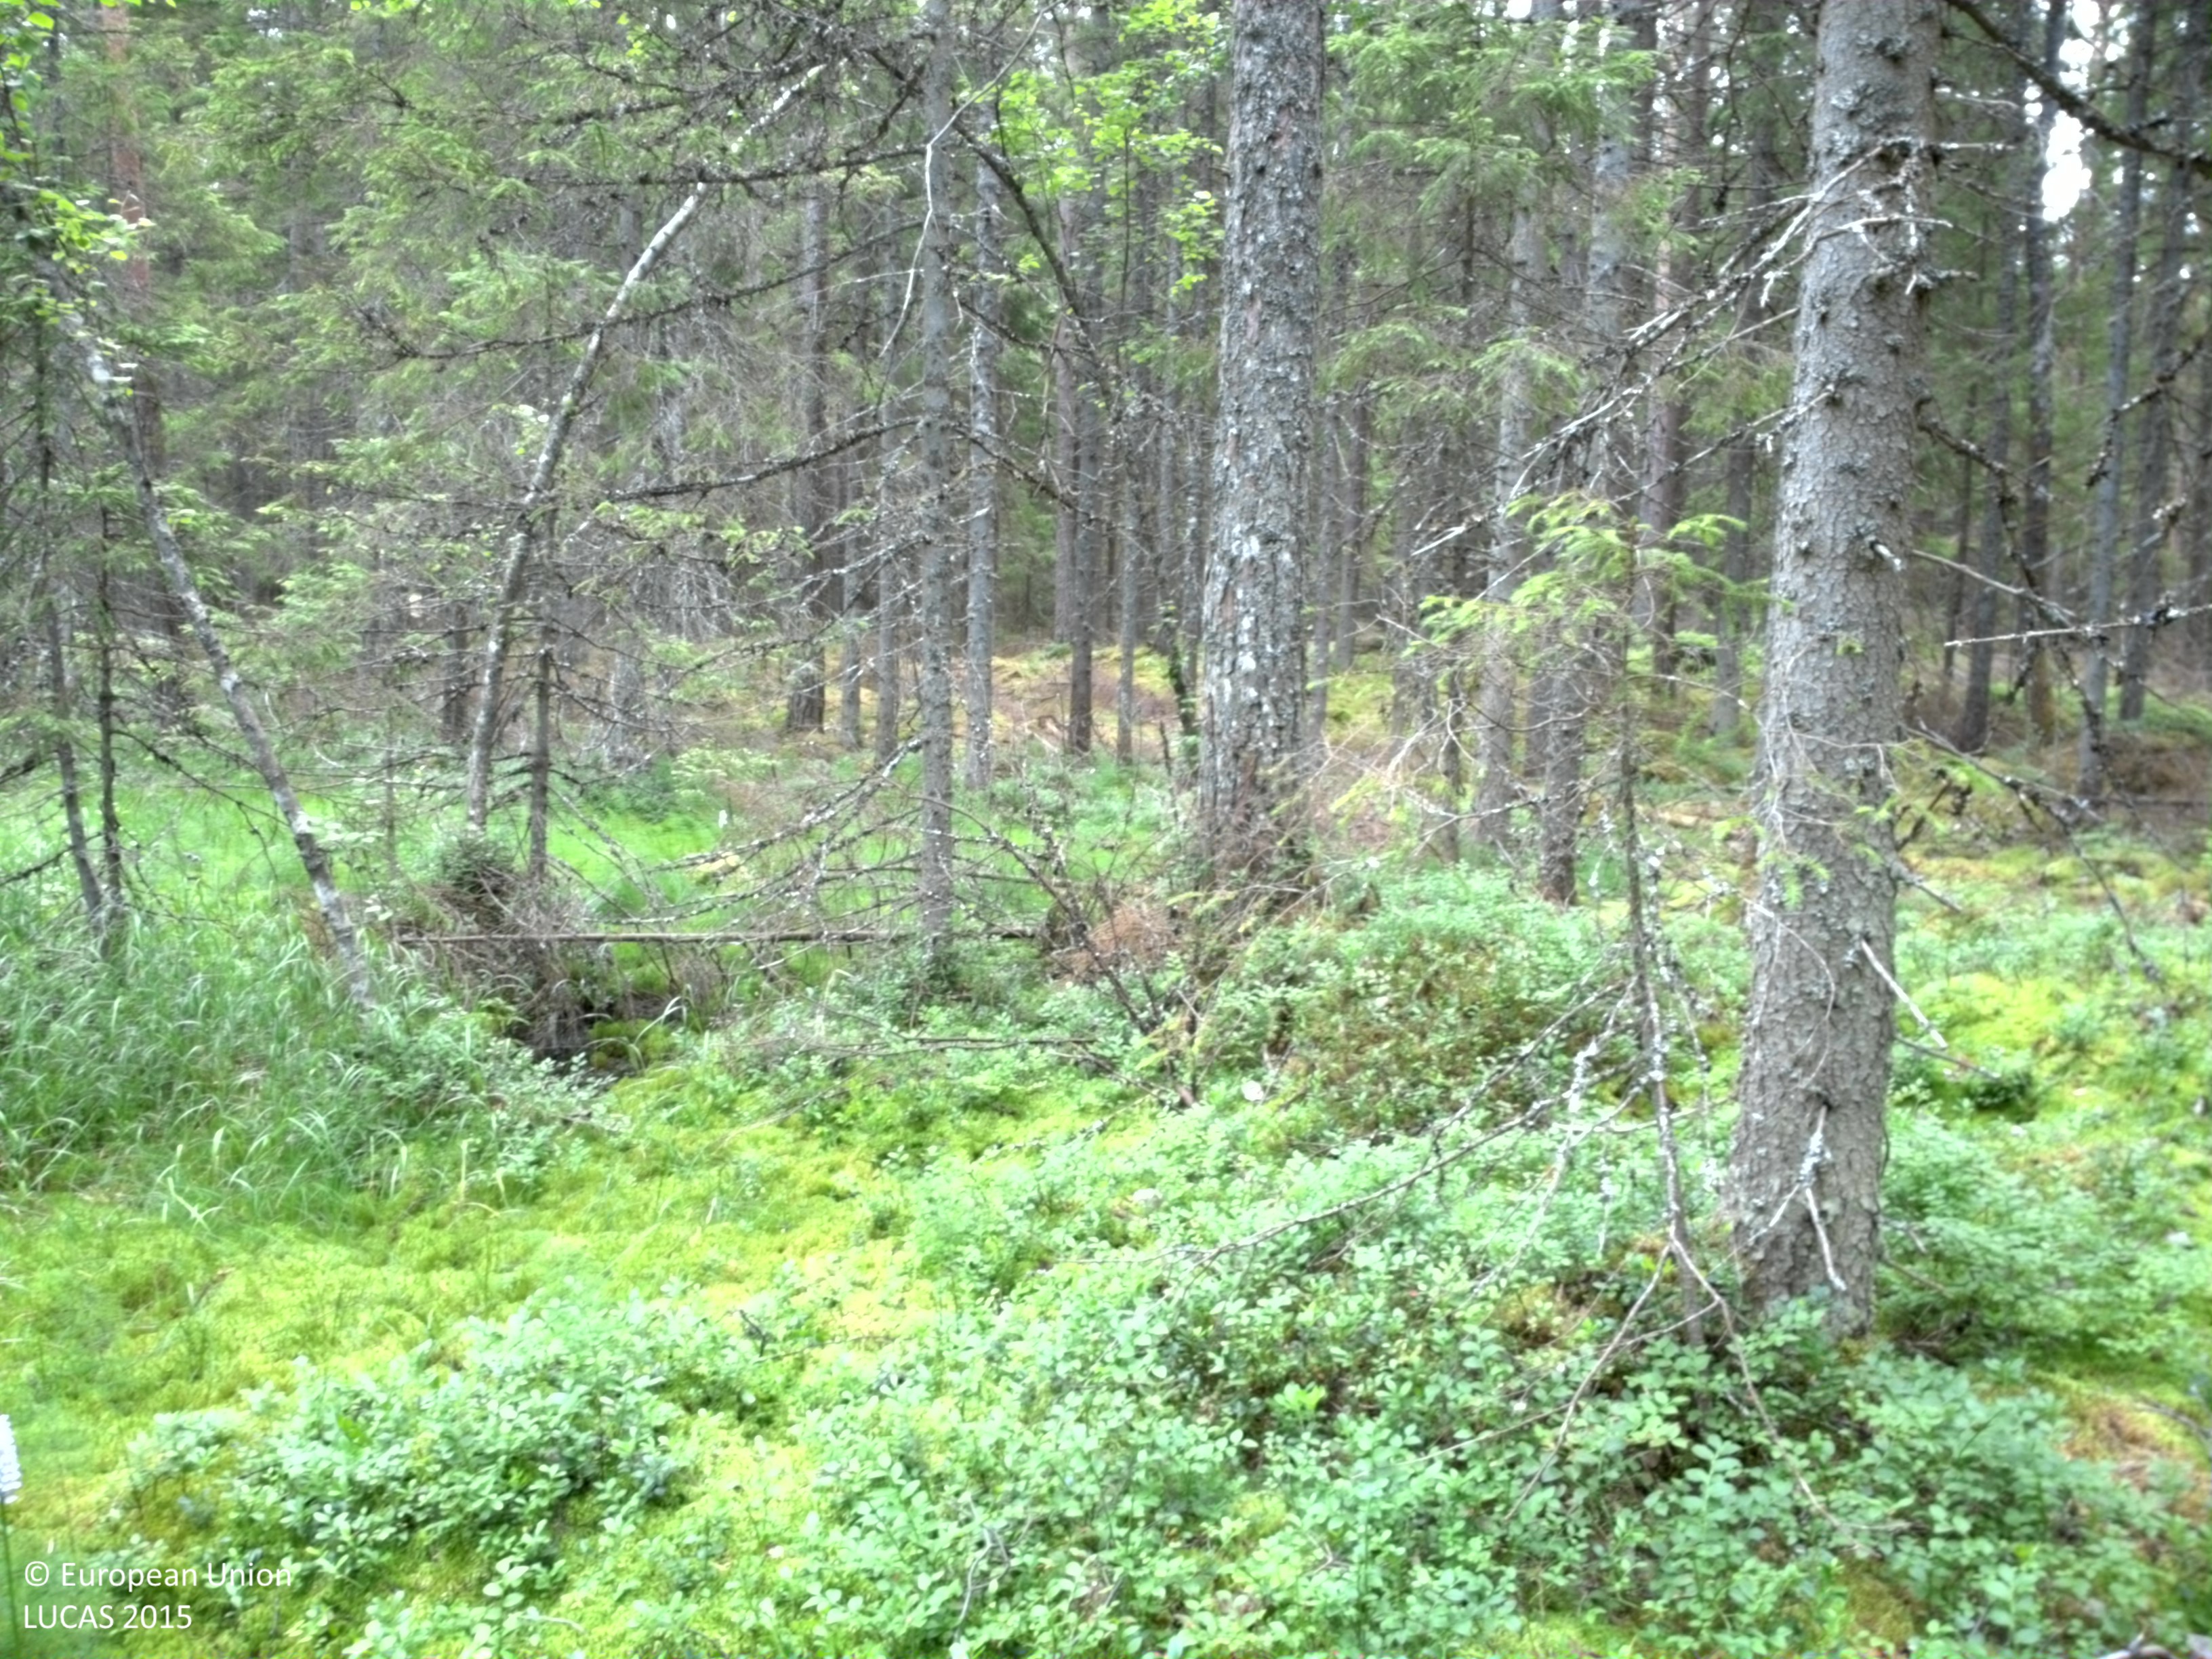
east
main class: Woodland
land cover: Spruce dominated mixed woodland
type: boreal forest
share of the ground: 25 - 50 %
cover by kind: lichens and mosses 40 %, coniferous forest trees 25 %, herbaceous plants 20 %, broadleaved forest trees 15 %
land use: Forestry
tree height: > 5 m
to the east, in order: Spruce dominated mixed woodland; Spruce dominated coniferous woodland; Tracks; Spruce dominated coniferous woodland; Ditches and canals; Temporary grasslands; Broadleaved woodland; Paved roads, cycling and walking lanes; Spruce dominated coniferous woodland; Tracks; Spruce dominated coniferous woodland
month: July
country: SE
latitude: 58.9639
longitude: 14.7744
